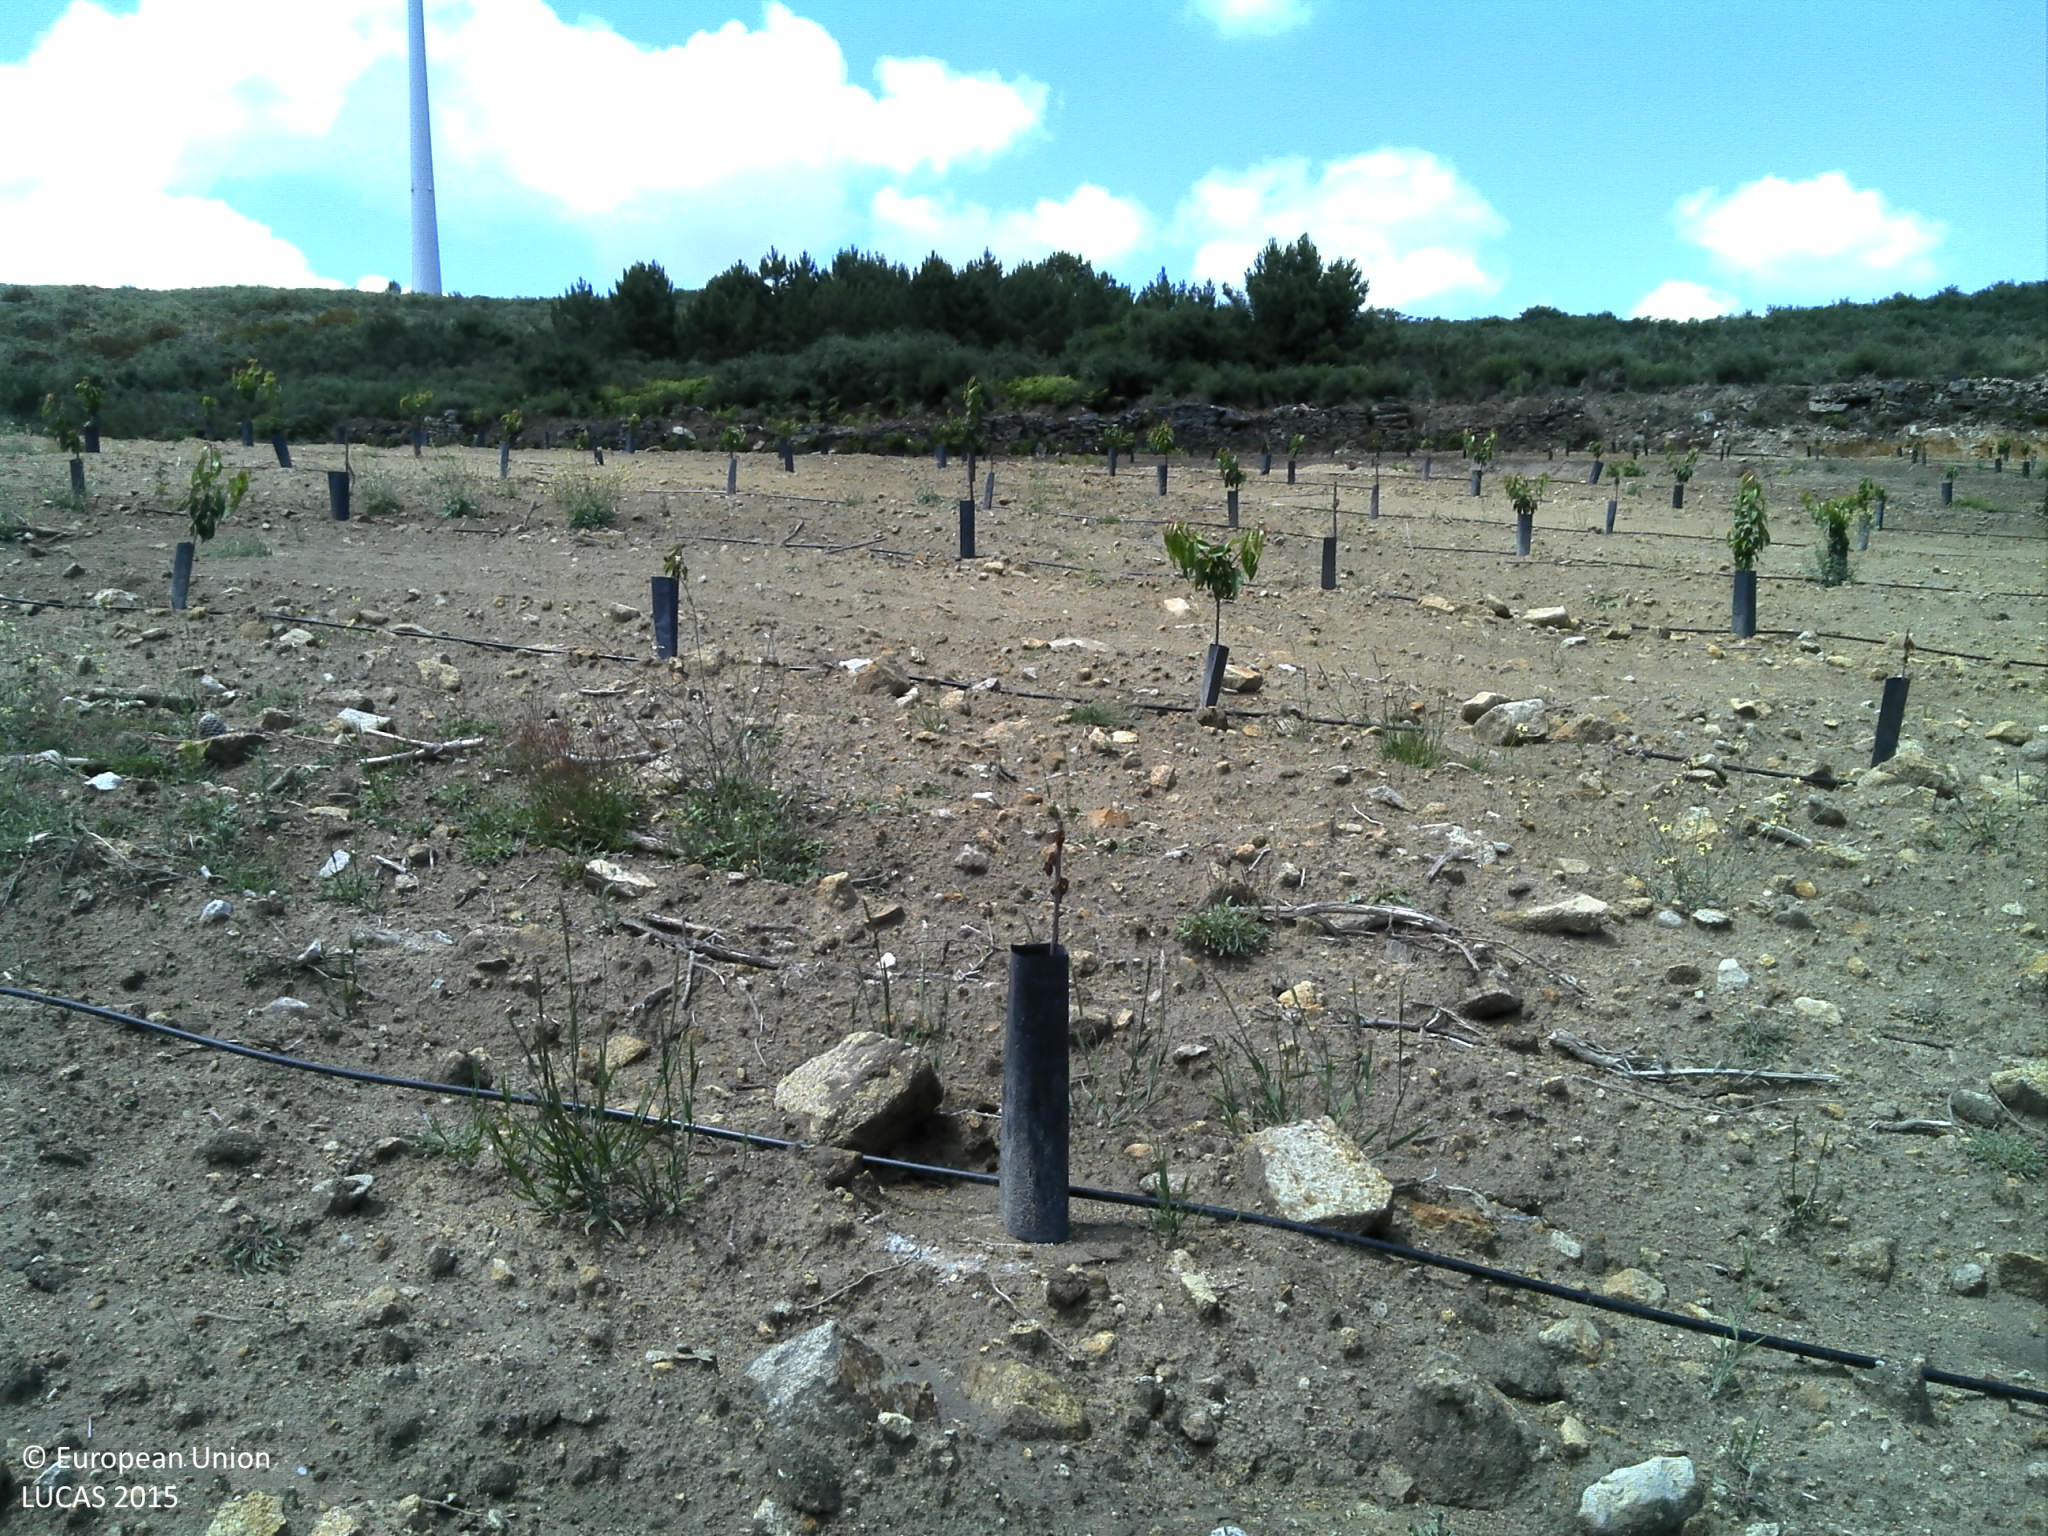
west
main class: Cropland
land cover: Cherry fruit
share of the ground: < 10 %
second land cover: Other bare soil
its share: > 75 %
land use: Agriculture (excluding fallow land and kitchen gardens)
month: June
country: PT
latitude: 41.0526
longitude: -7.6497
